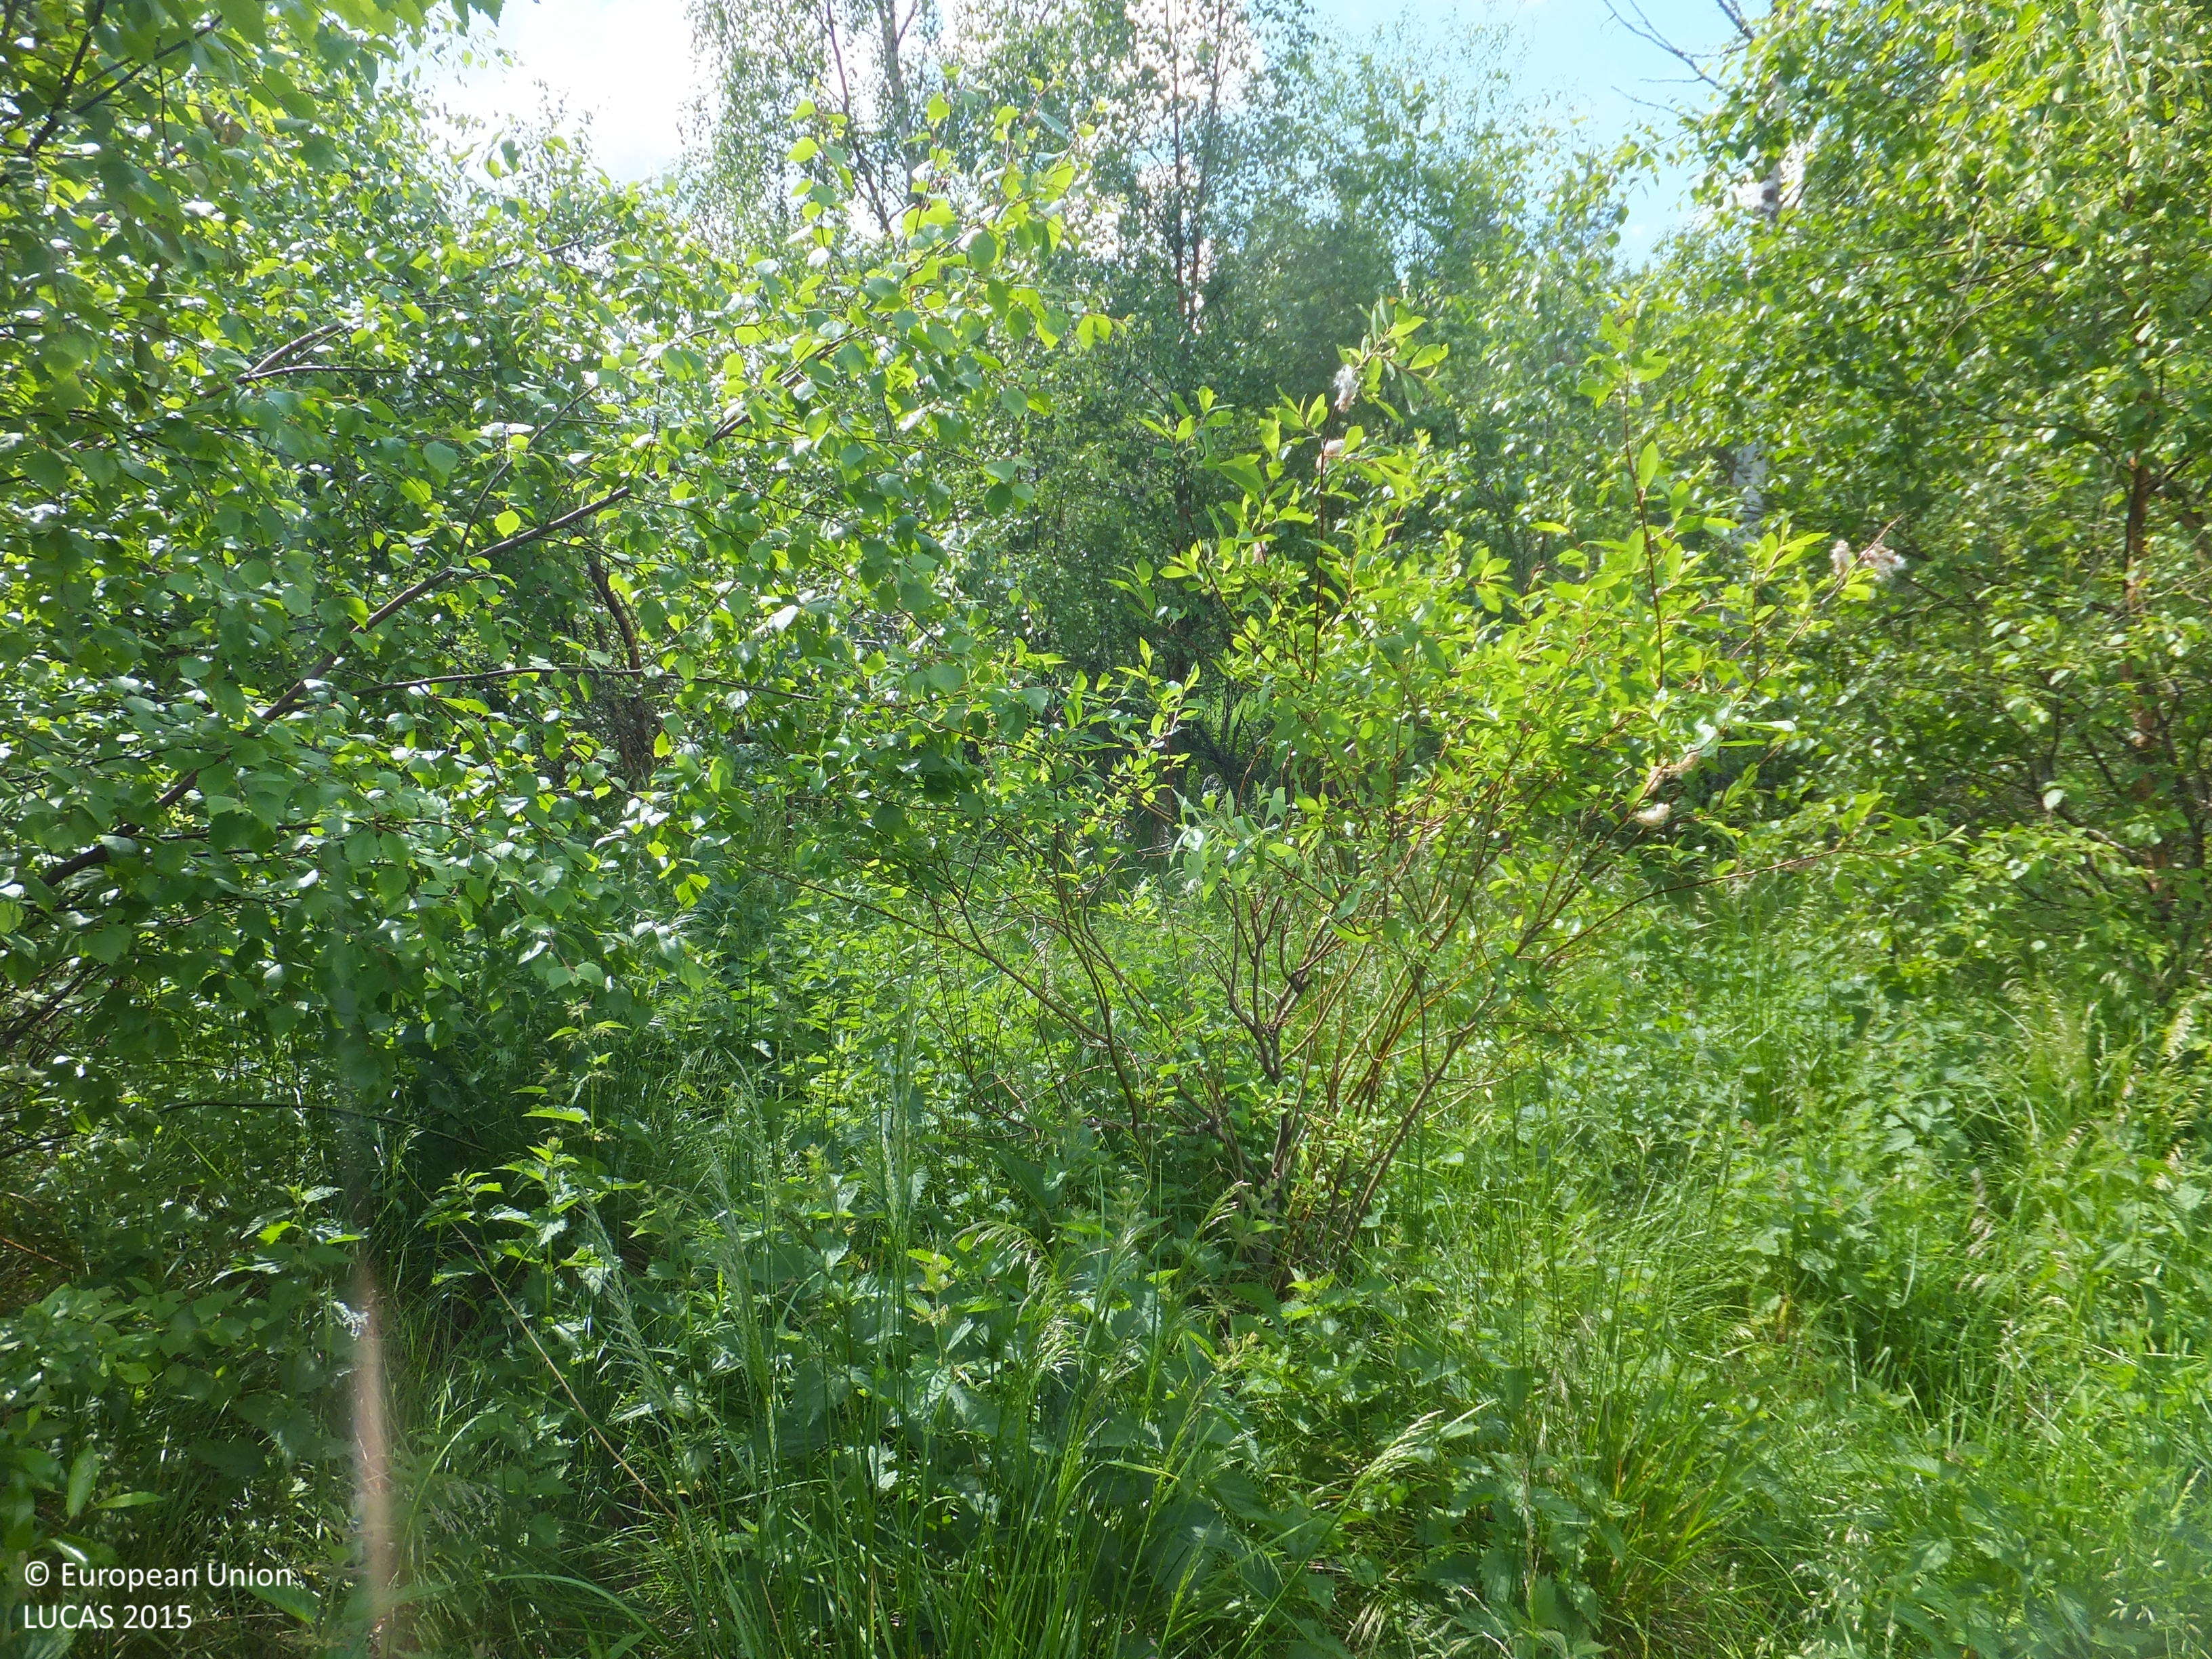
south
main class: Shrubland
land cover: Shrubland with sparse tree cover
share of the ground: 50 - 75 %
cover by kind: shrubs 60 %, herbaceous plants 35 %, broadleaved forest trees 5 %
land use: Abandoned areas
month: June
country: FI
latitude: 63.1704
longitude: 24.1570
